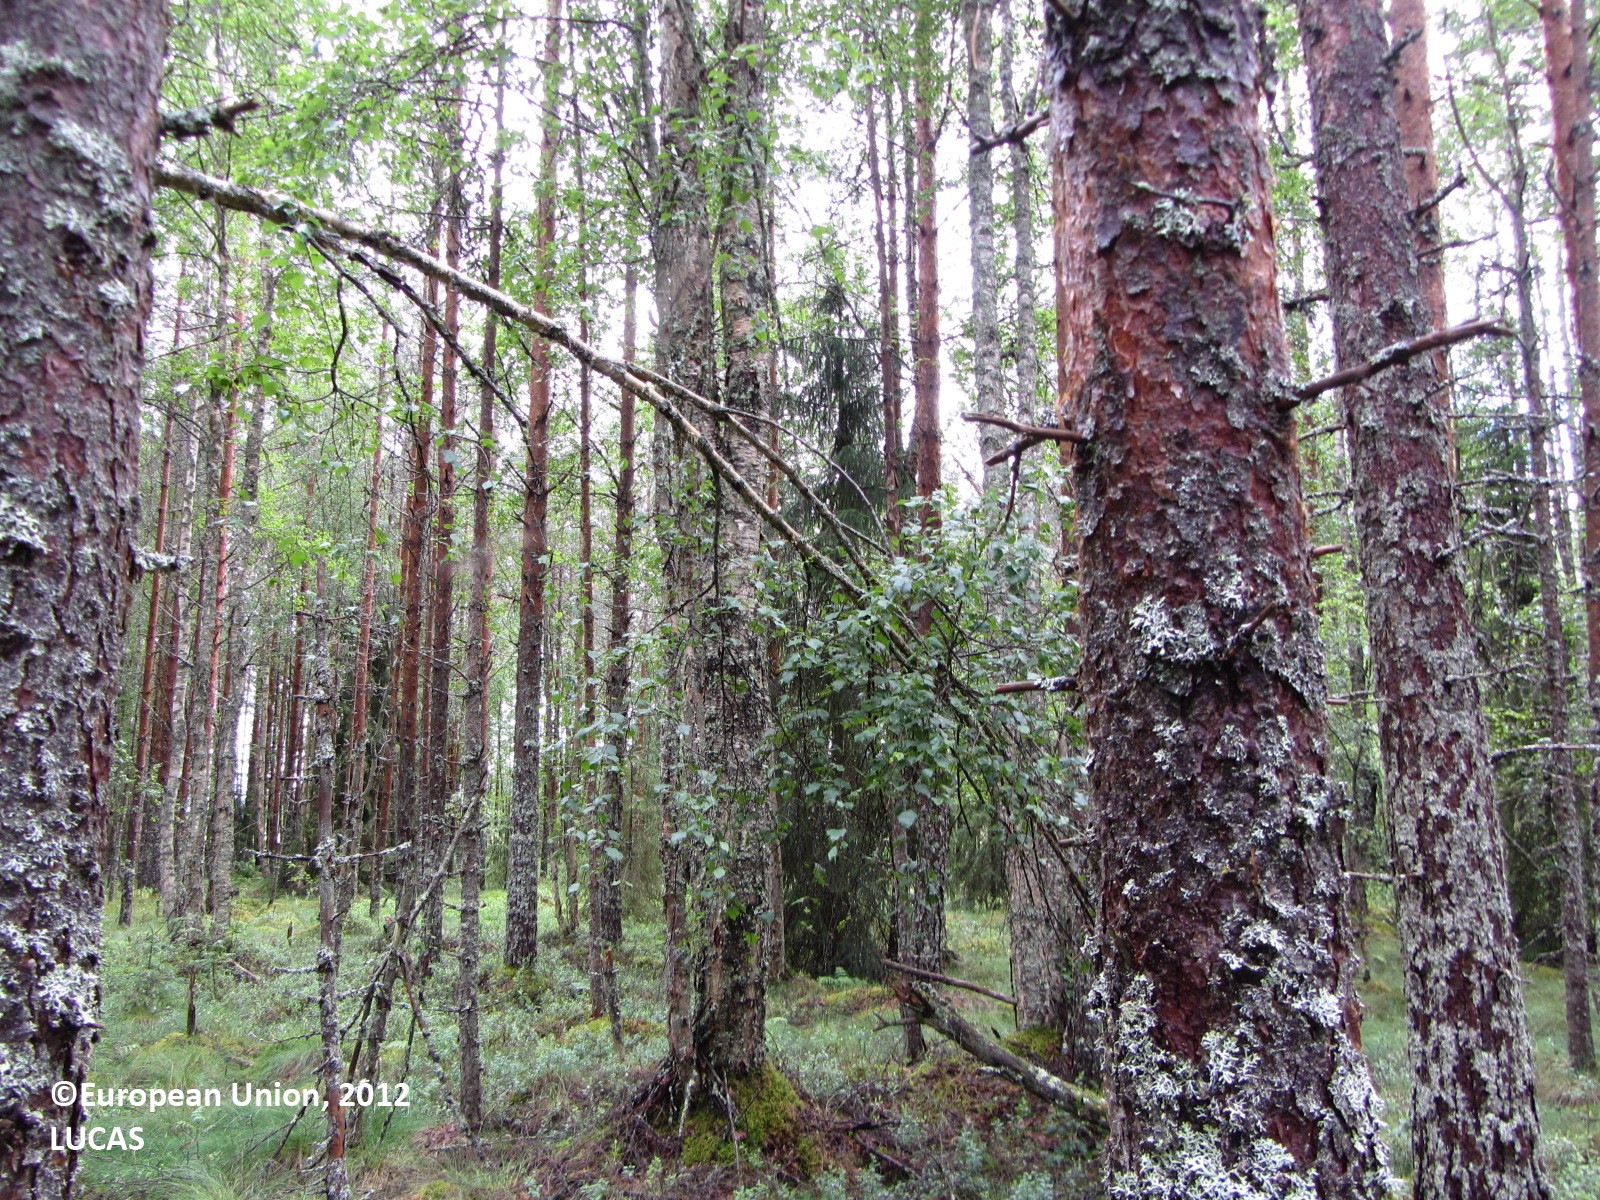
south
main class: Woodland
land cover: Pine dominated mixed woodland
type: boreal forest
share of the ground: > 75 %
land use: Forestry
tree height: > 5 m
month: July
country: FI
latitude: 63.8967
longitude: 25.6015
